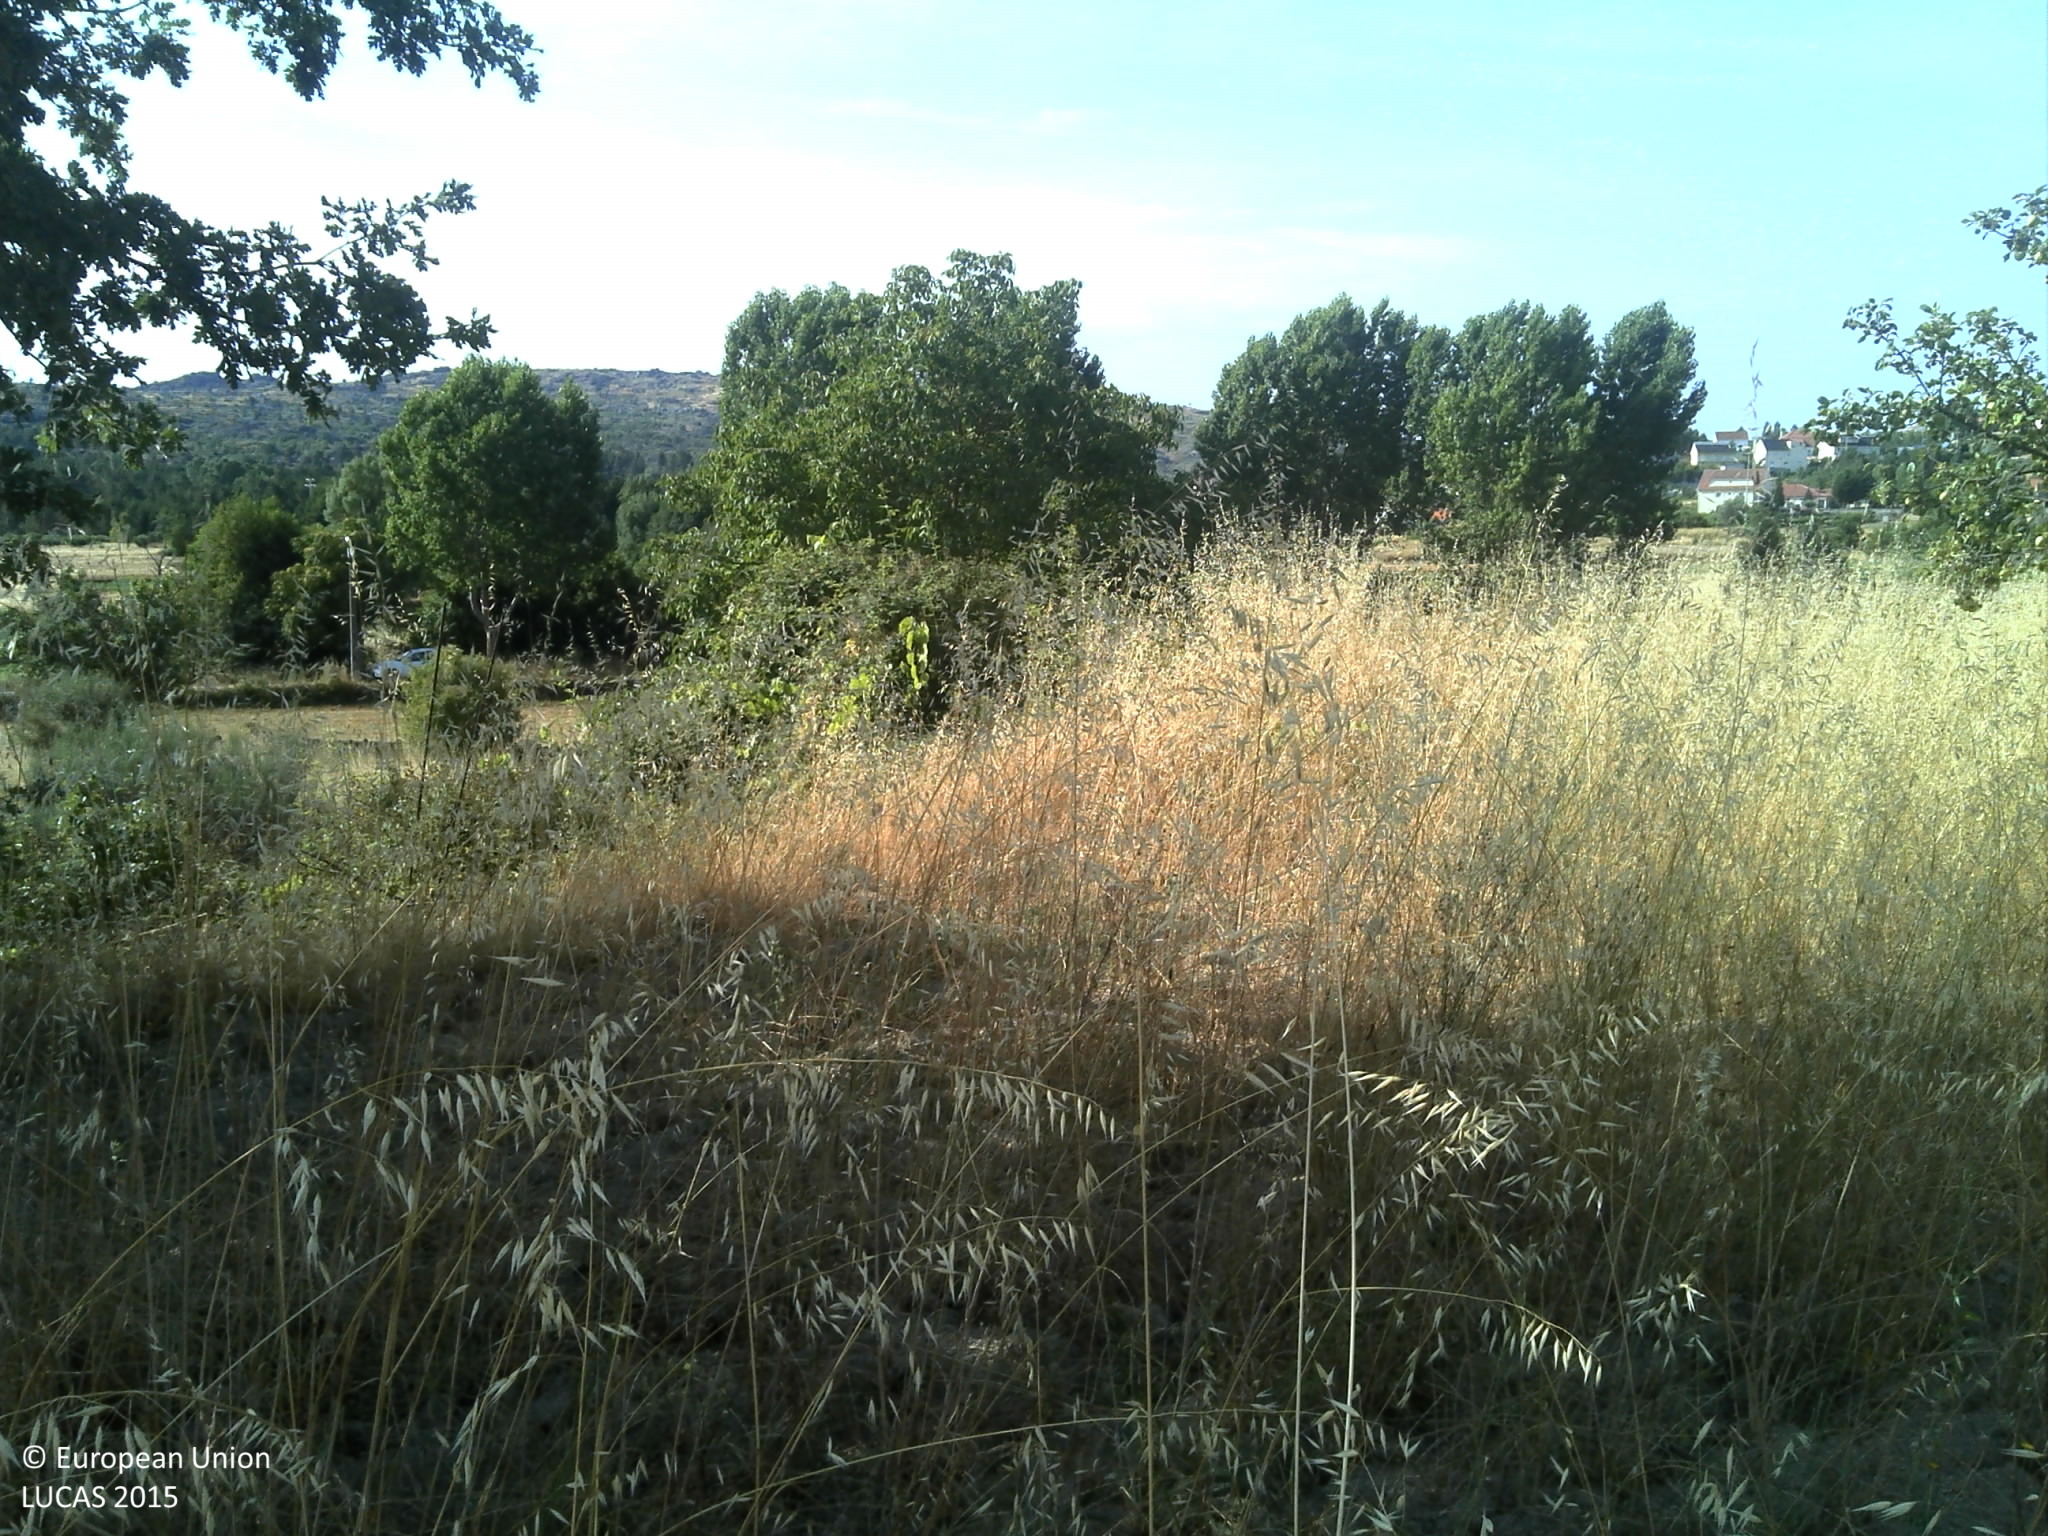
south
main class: Cropland
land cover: Nuts trees
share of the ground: < 10 %
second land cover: Spontaneously vegetated surfaces
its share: 50 - 75 %
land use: Agriculture (excluding fallow land and kitchen gardens)
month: July
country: PT
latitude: 40.9456
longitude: -7.4238
